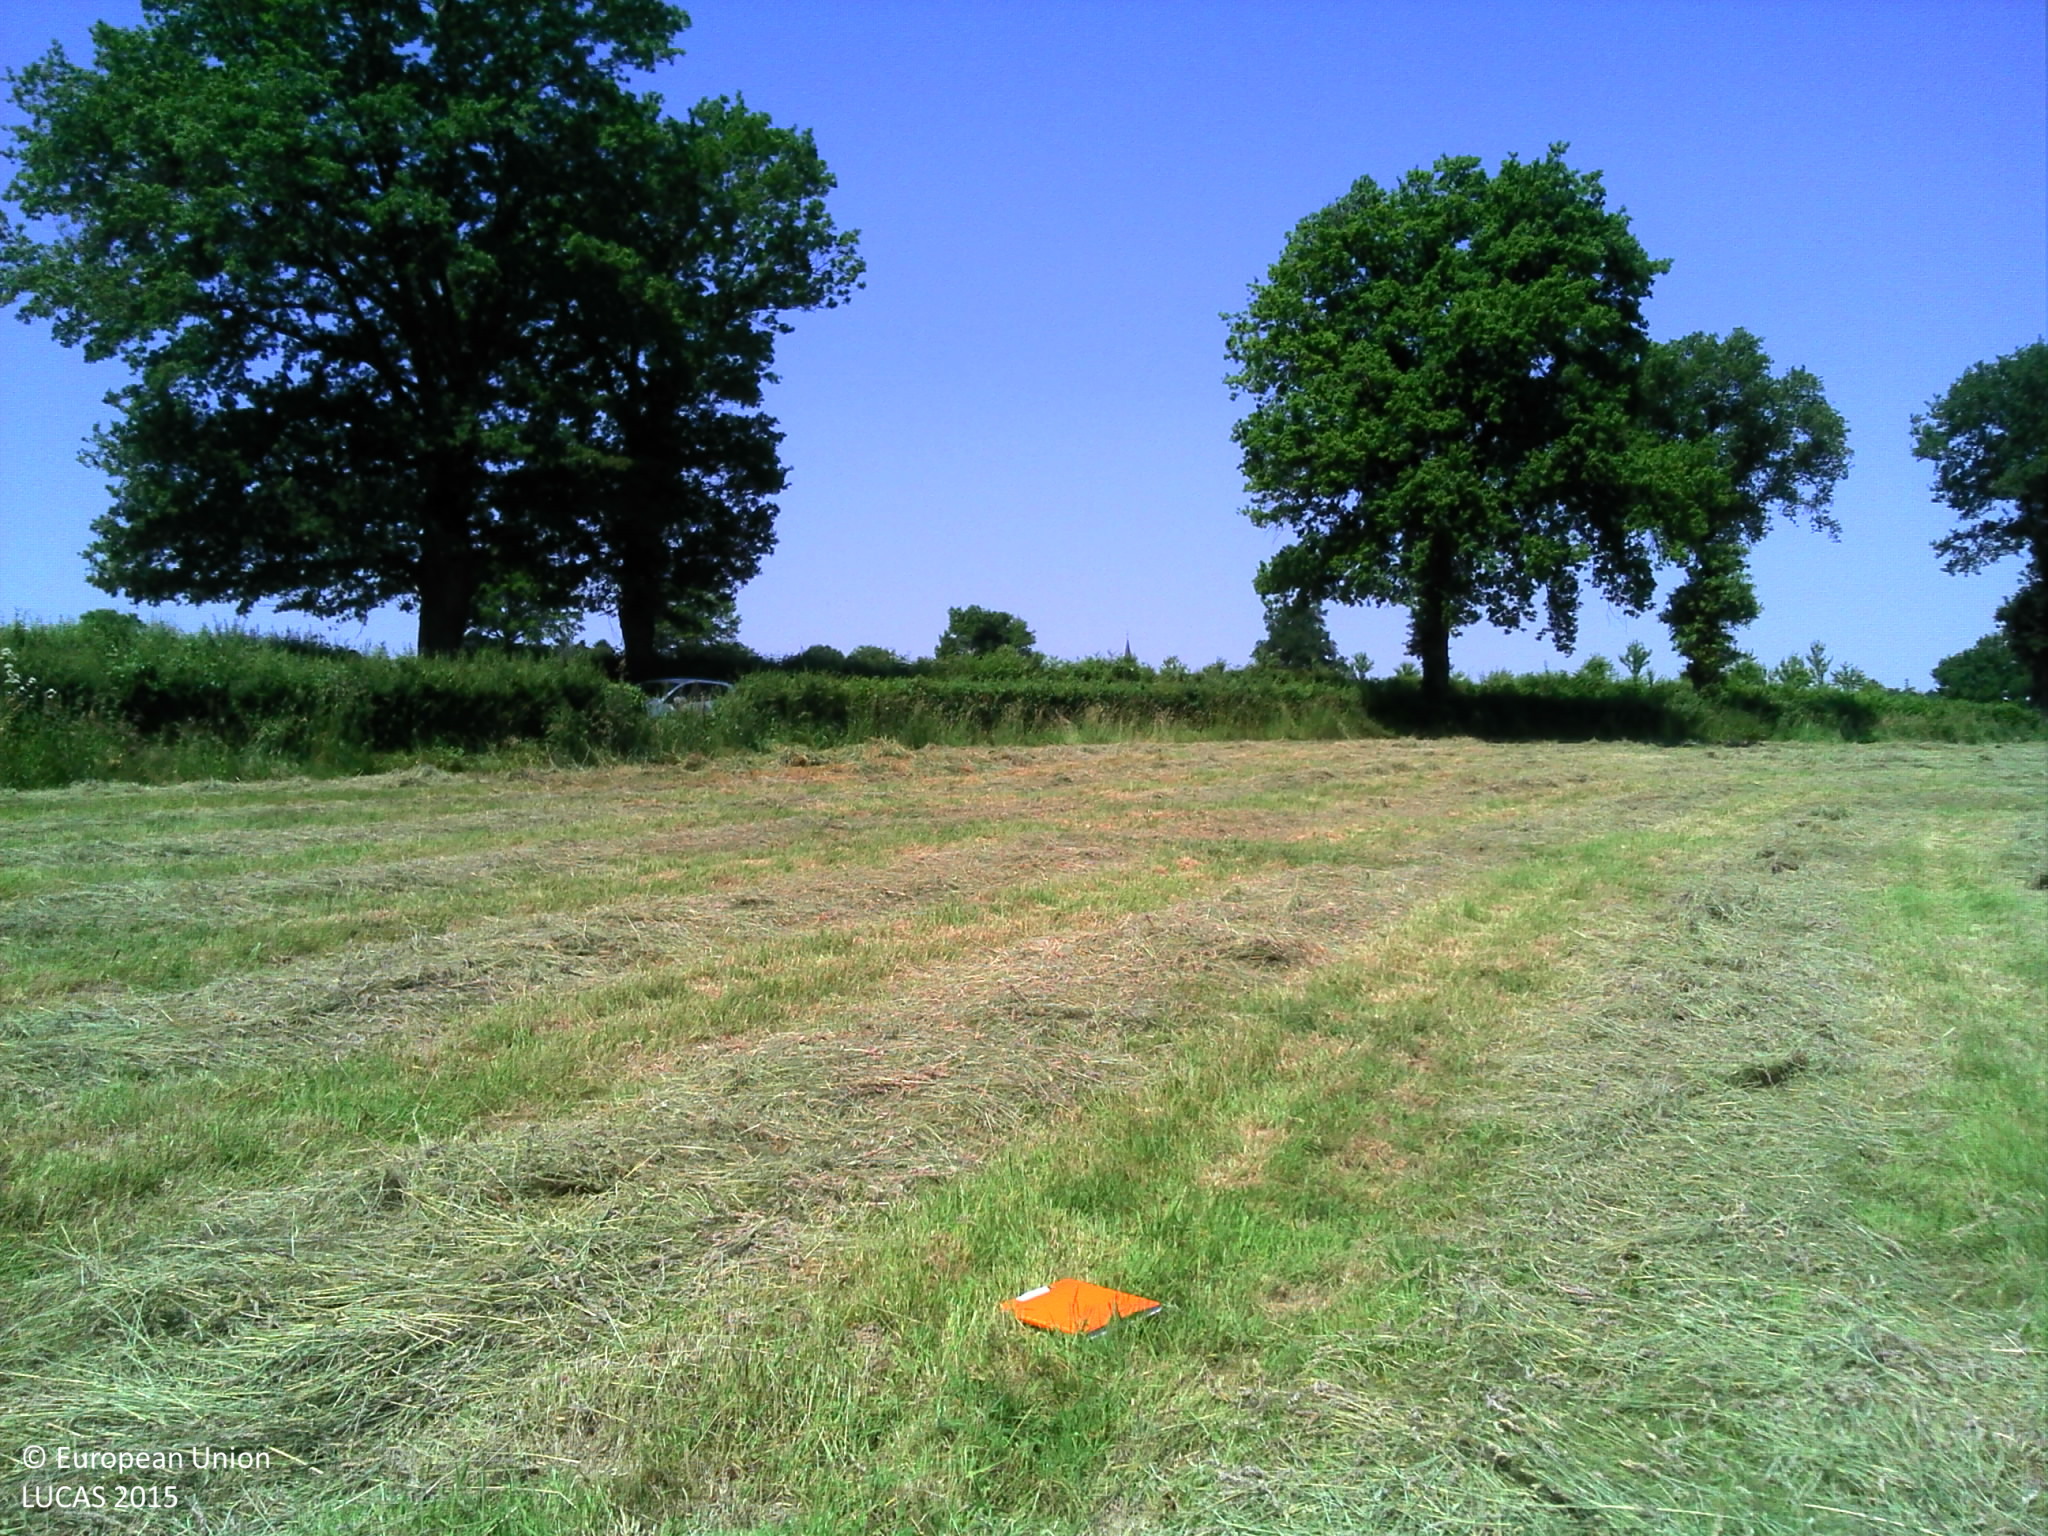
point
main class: Grassland
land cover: Grassland without tree/shrub cover
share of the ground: > 75 %
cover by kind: herbaceous plants 100 %
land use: Agriculture (excluding fallow land and kitchen gardens)
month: June
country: FR
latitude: 46.3551
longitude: 2.7058
